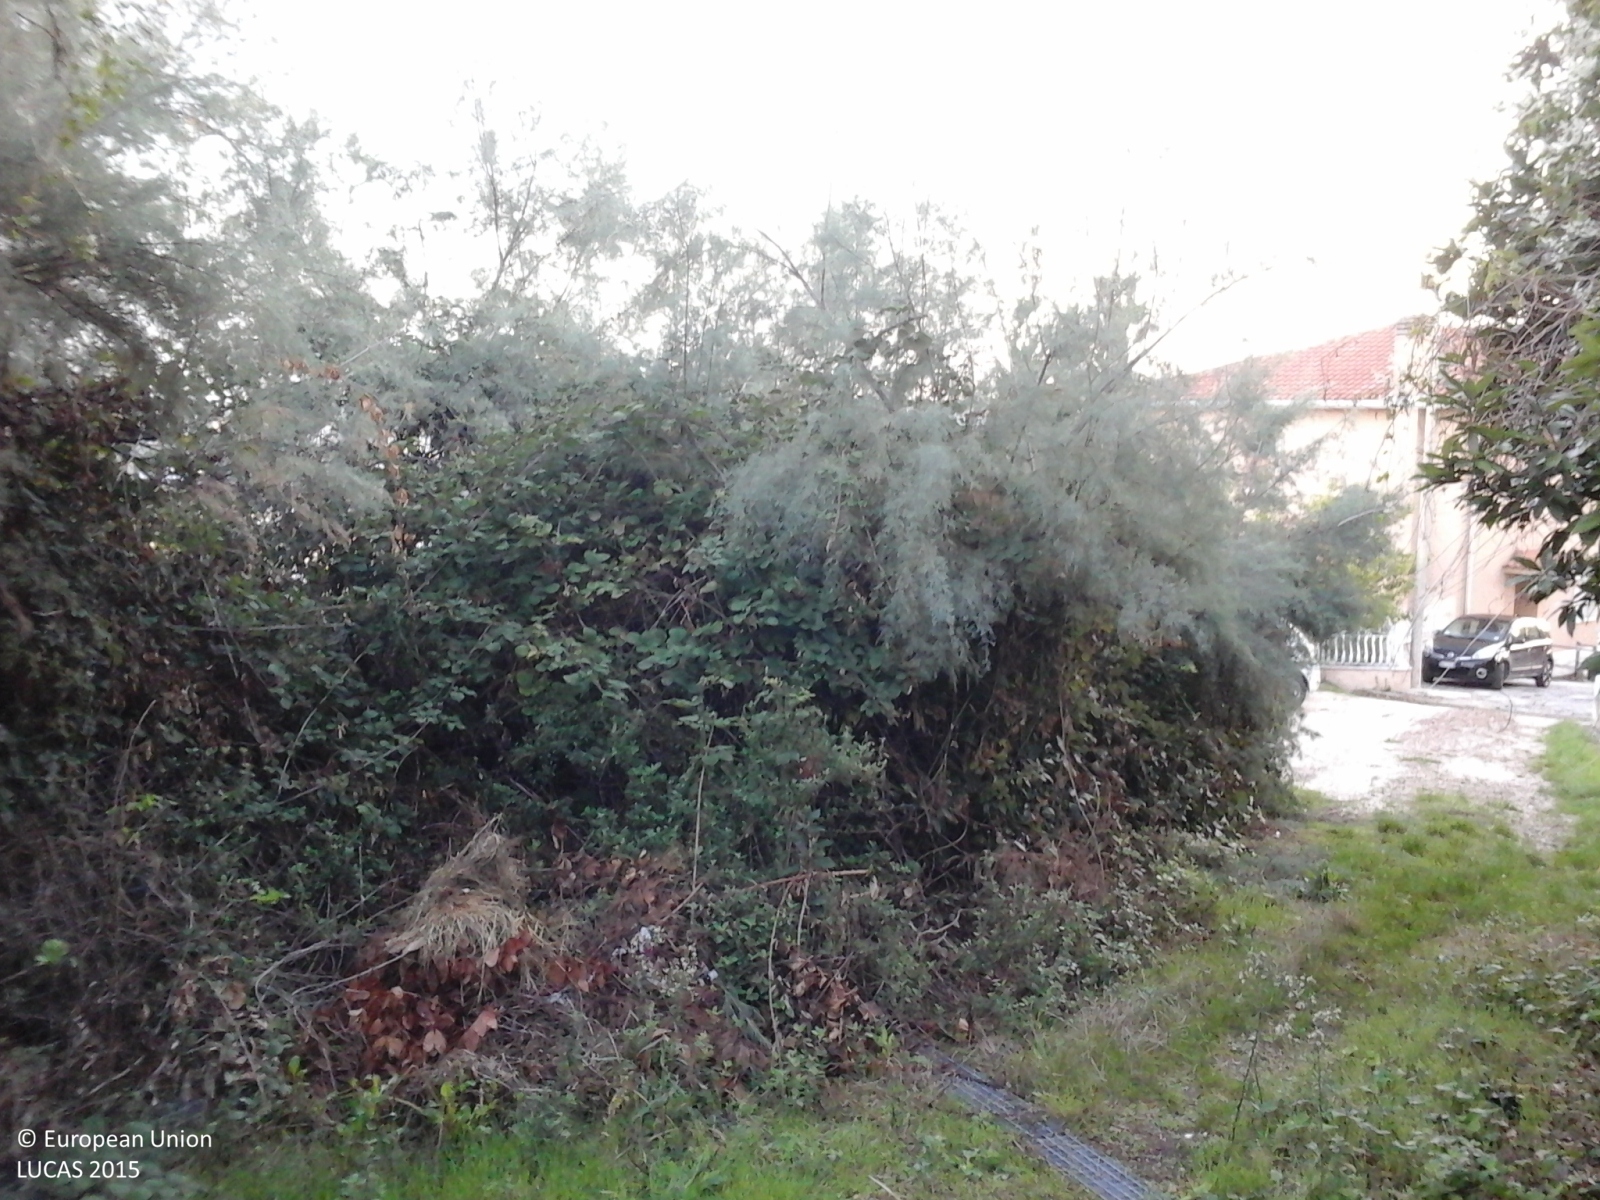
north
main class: Woodland
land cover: Broadleaved woodland
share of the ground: > 75 %
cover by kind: broadleaved forest trees 100 %
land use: Residential
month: October
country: IT
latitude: 43.6055
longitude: 13.4979
